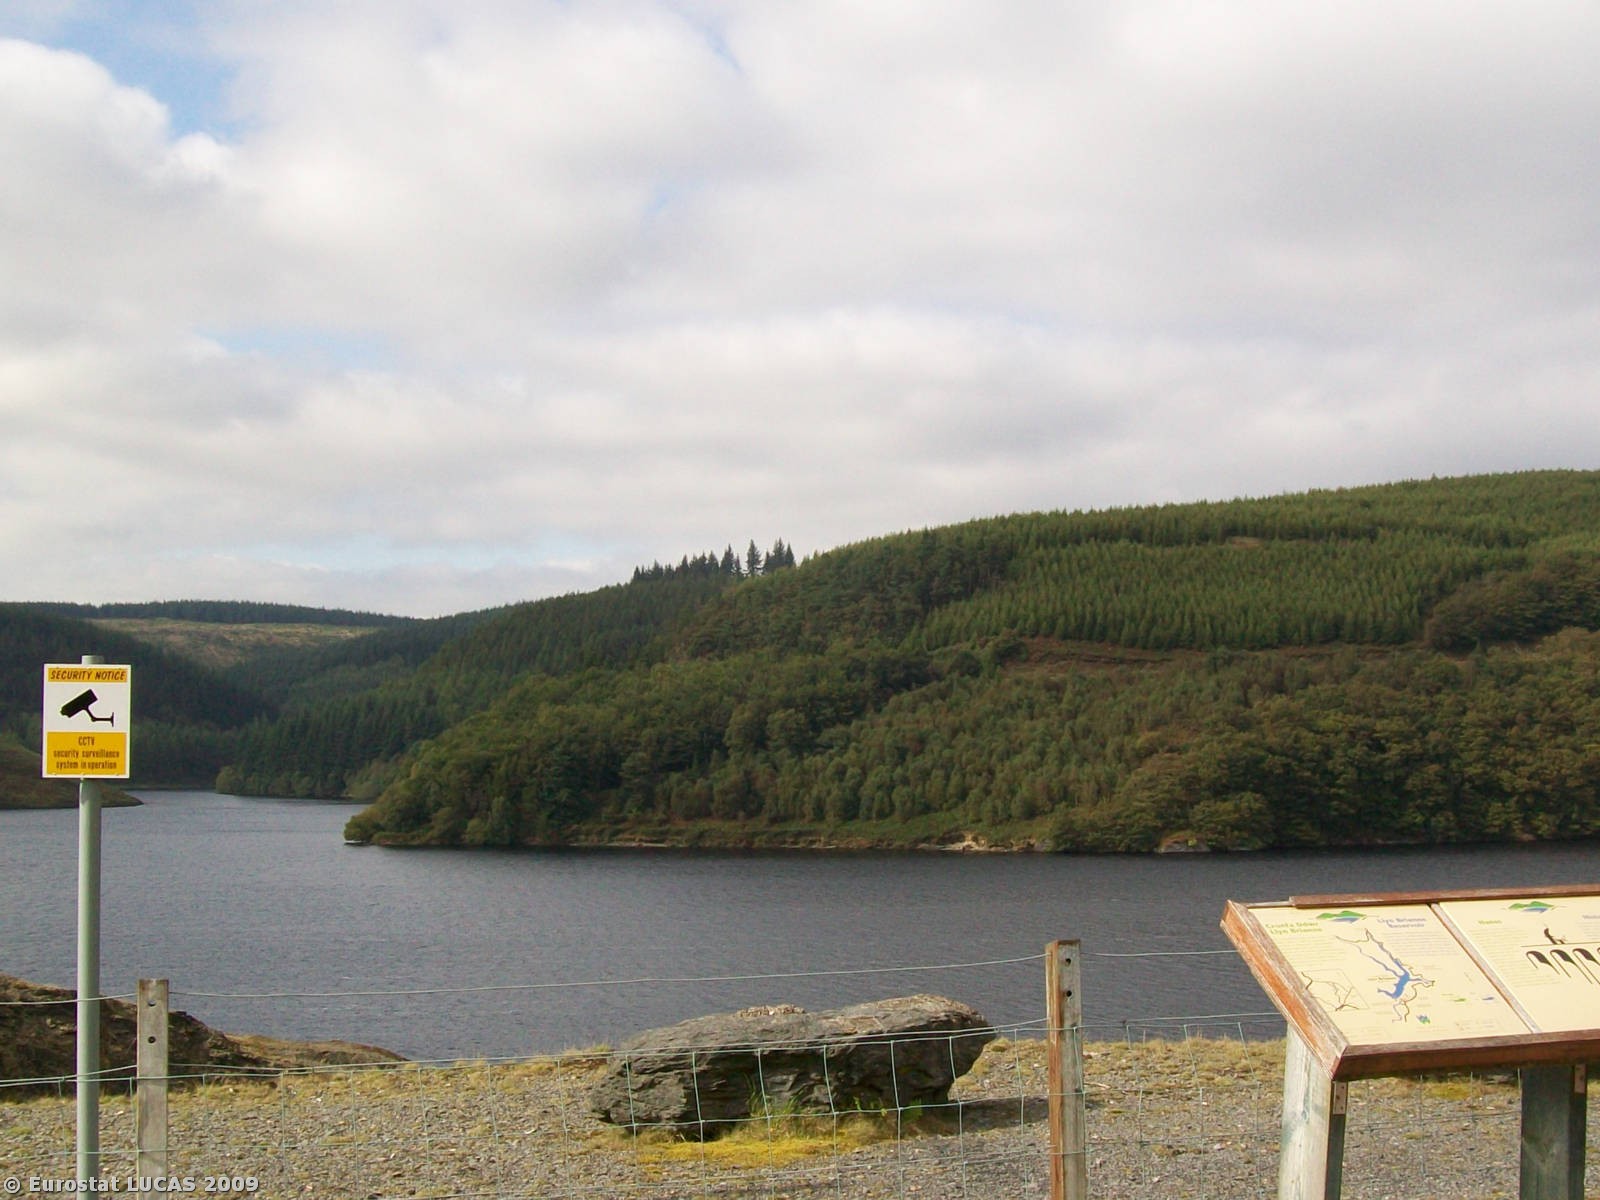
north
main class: Shrubland
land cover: Shrubland without tree cover
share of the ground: > 75 %
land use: Agriculture (excluding fallow land and kitchen gardens)
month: September
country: GB
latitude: 52.1521
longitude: -3.7849
